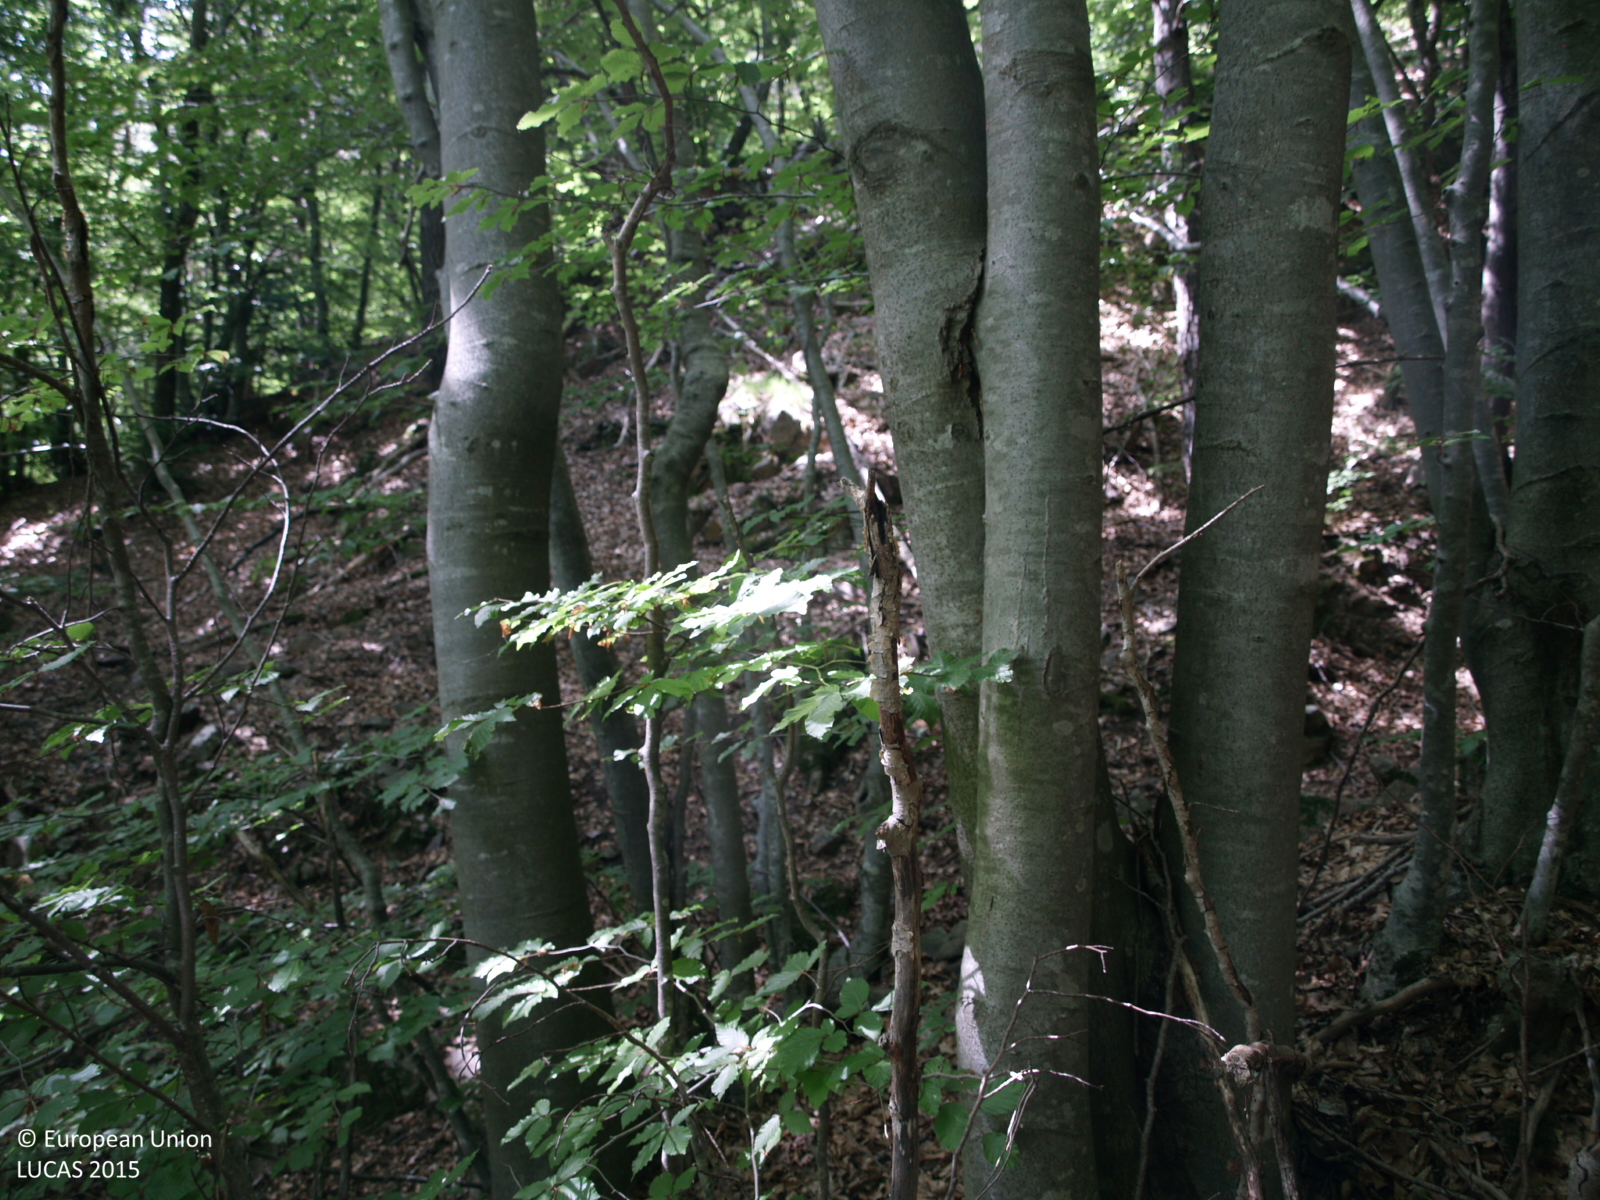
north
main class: Woodland
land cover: Broadleaved woodland
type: mountainous beech forest
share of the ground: > 75 %
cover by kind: broadleaved forest trees 100 %
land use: Forestry
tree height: > 5 m
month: May
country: IT
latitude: 45.8411
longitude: 11.0928
